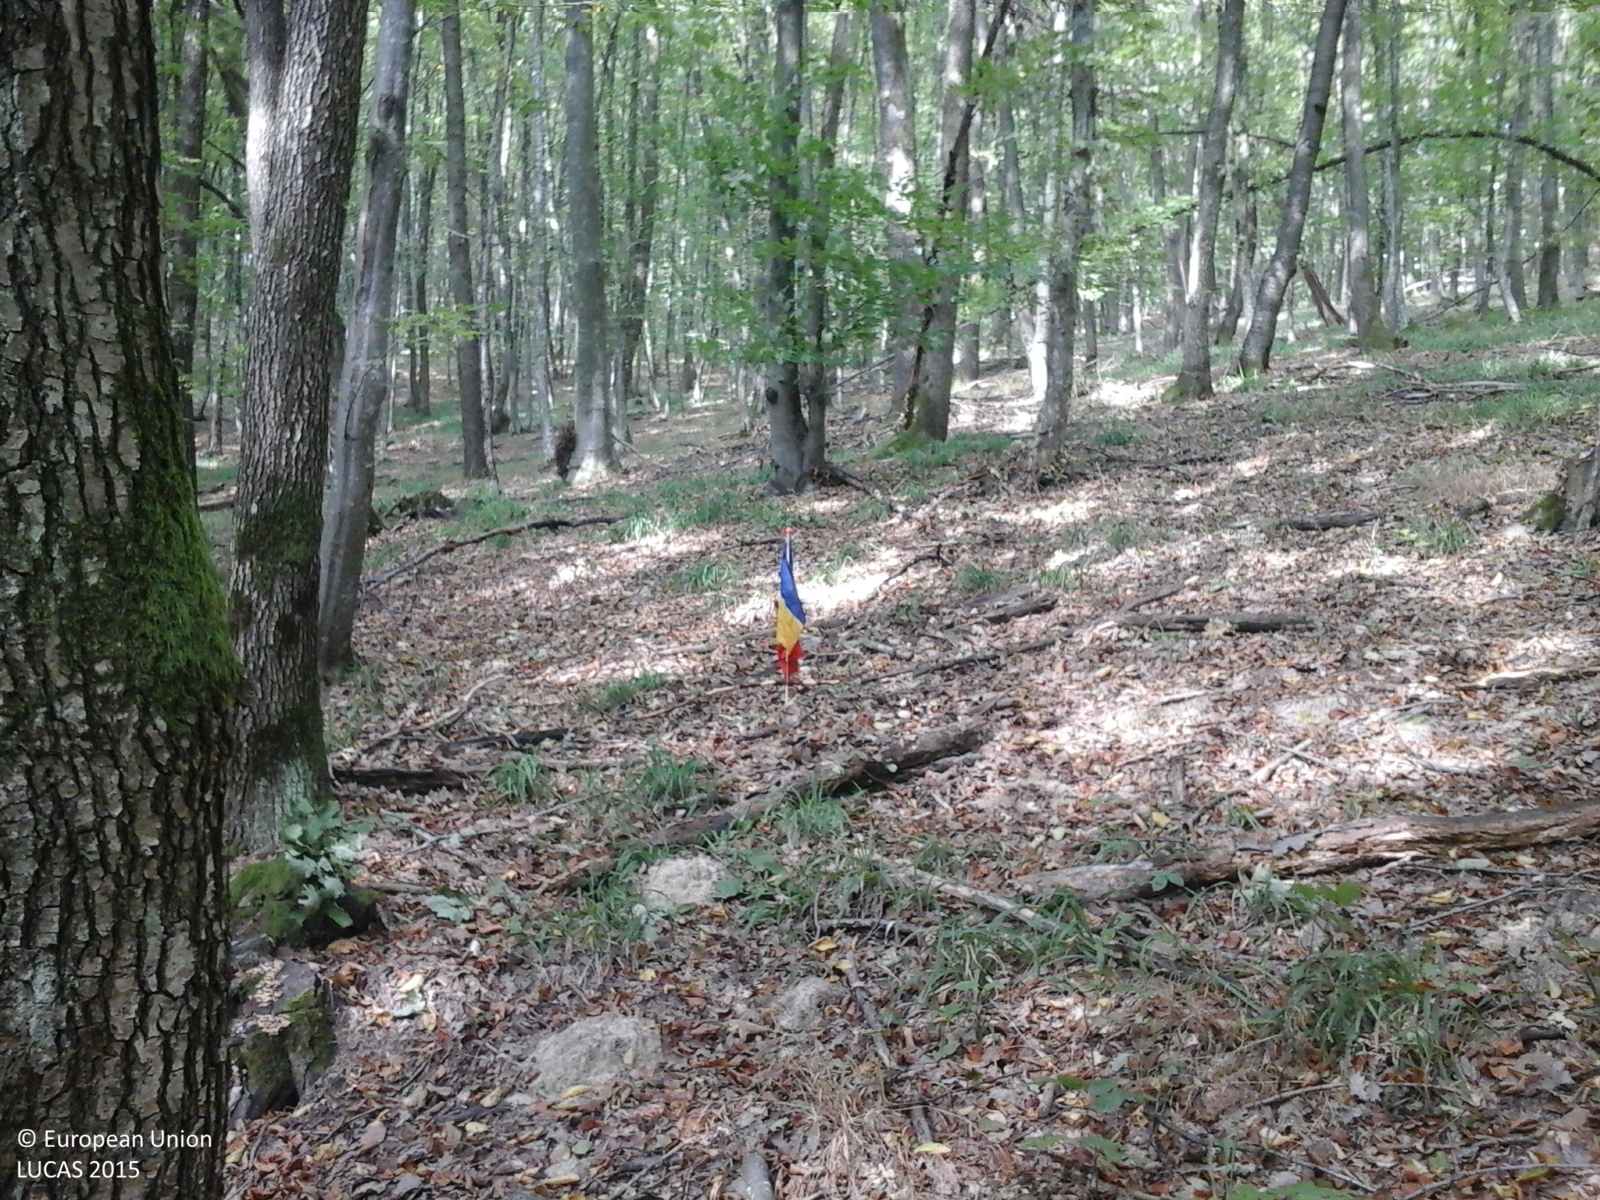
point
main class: Woodland
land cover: Broadleaved woodland
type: mesophytic deciduous forest
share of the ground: > 75 %
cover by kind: broadleaved forest trees 100 %
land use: Forestry
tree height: > 5 m
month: September
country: RO
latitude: 47.1908
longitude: 23.7633
